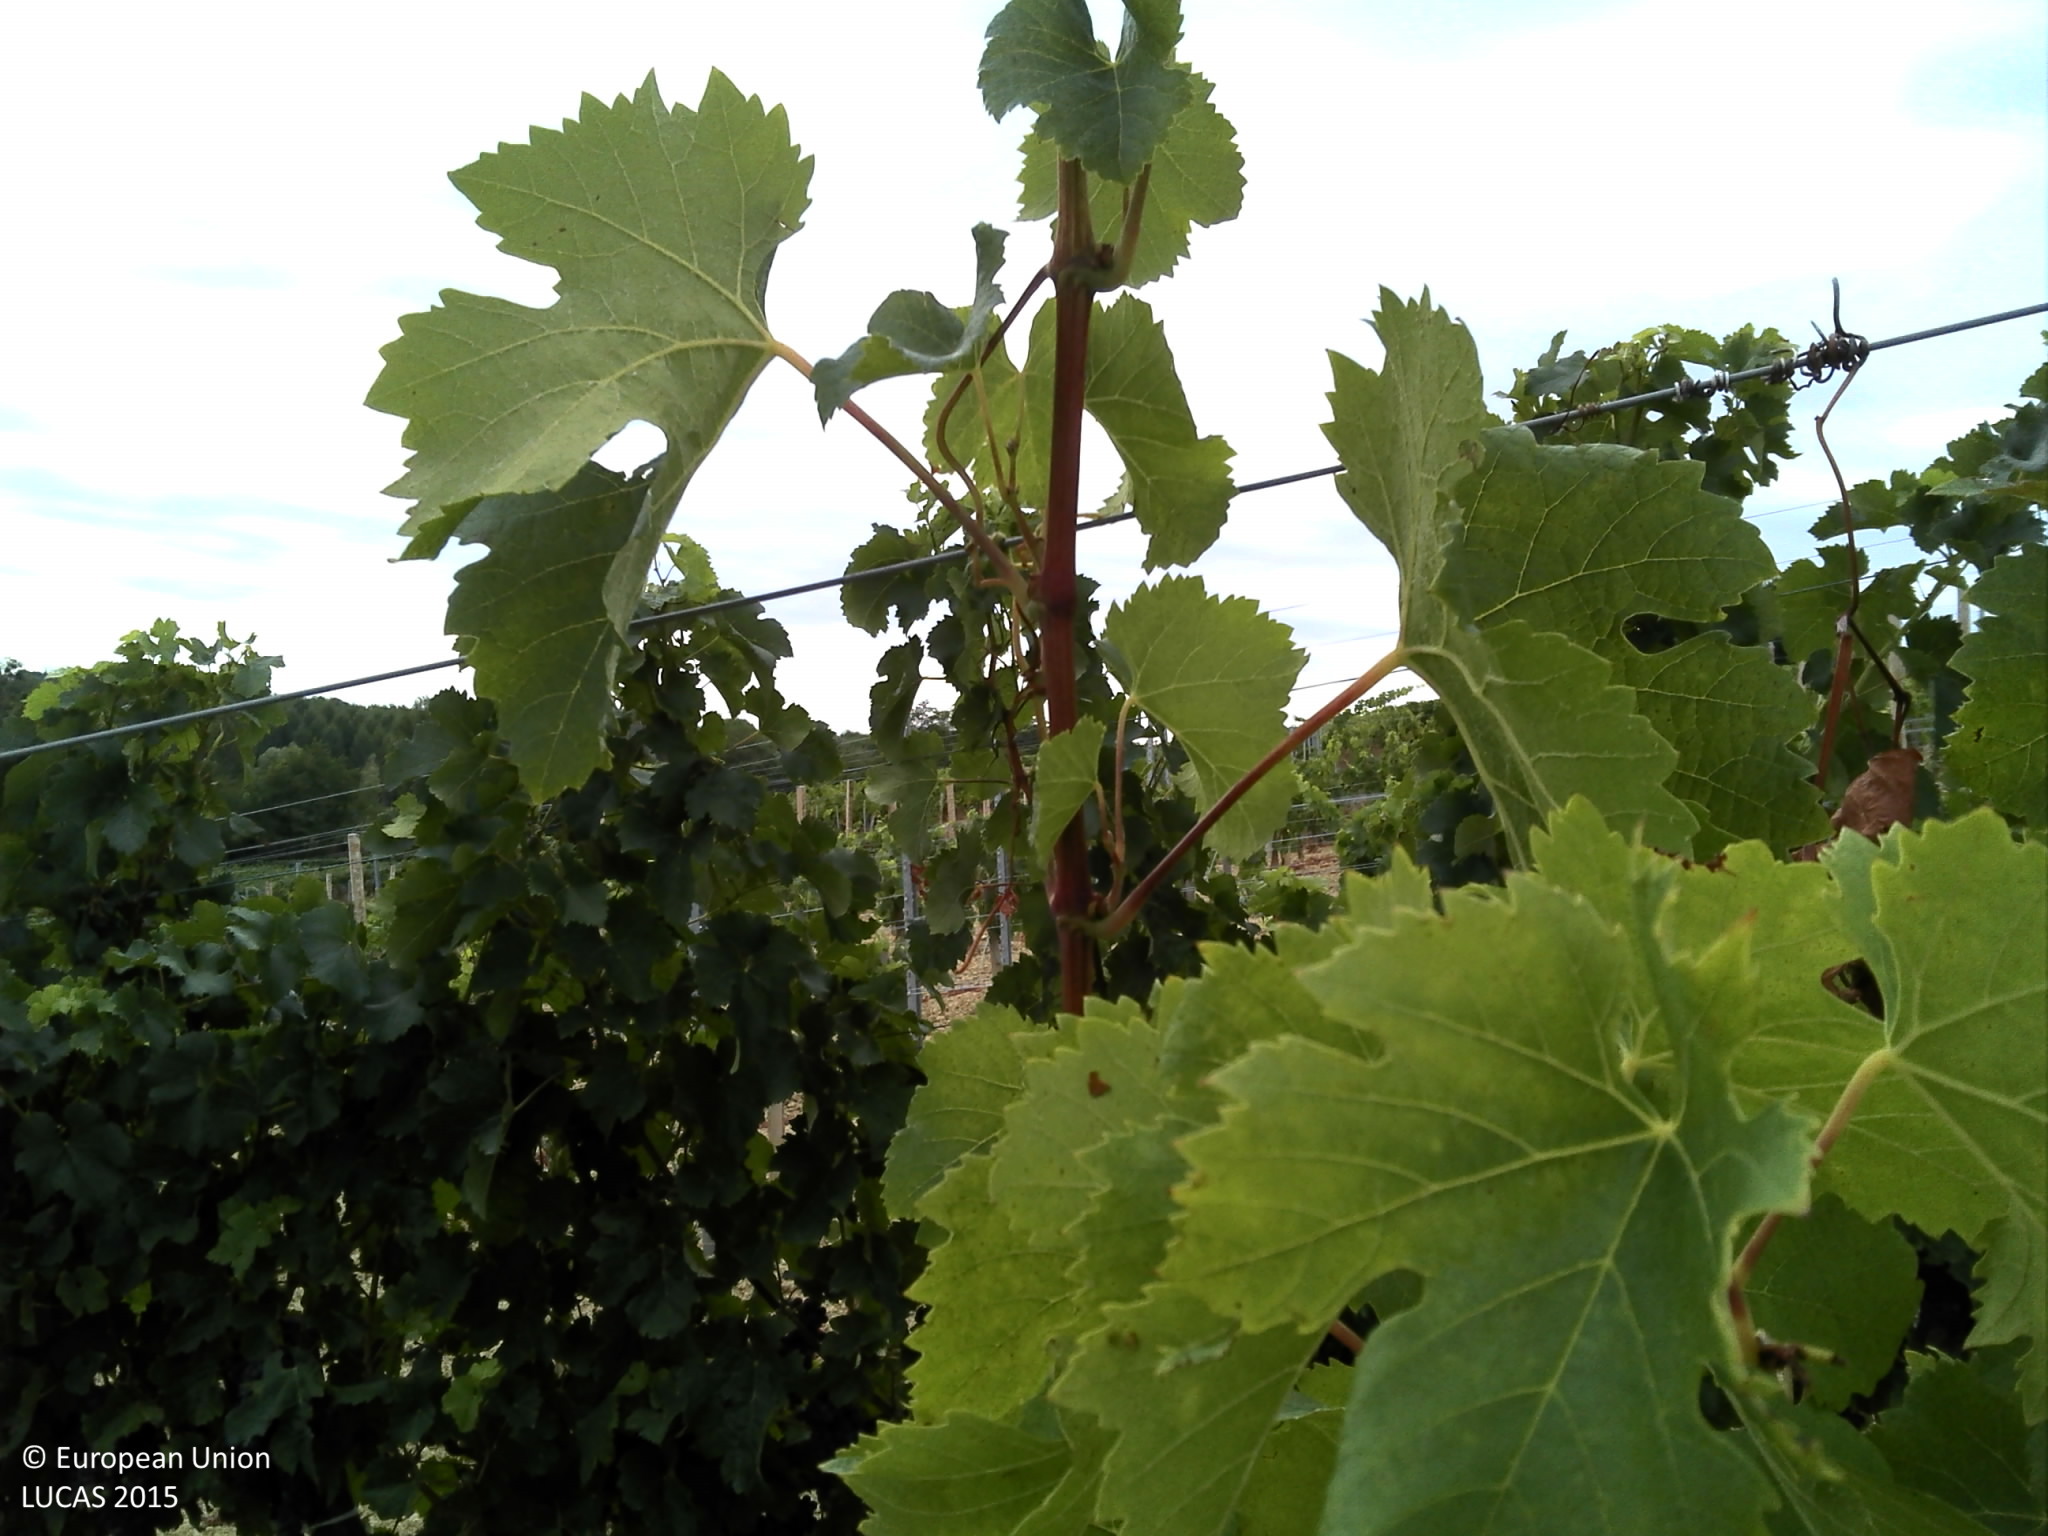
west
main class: Cropland
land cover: Vineyards
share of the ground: 10 - 25 %
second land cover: Other bare soil
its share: > 75 %
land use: Agriculture (excluding fallow land and kitchen gardens)
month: August
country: FR
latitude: 45.0781
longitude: -0.6019
